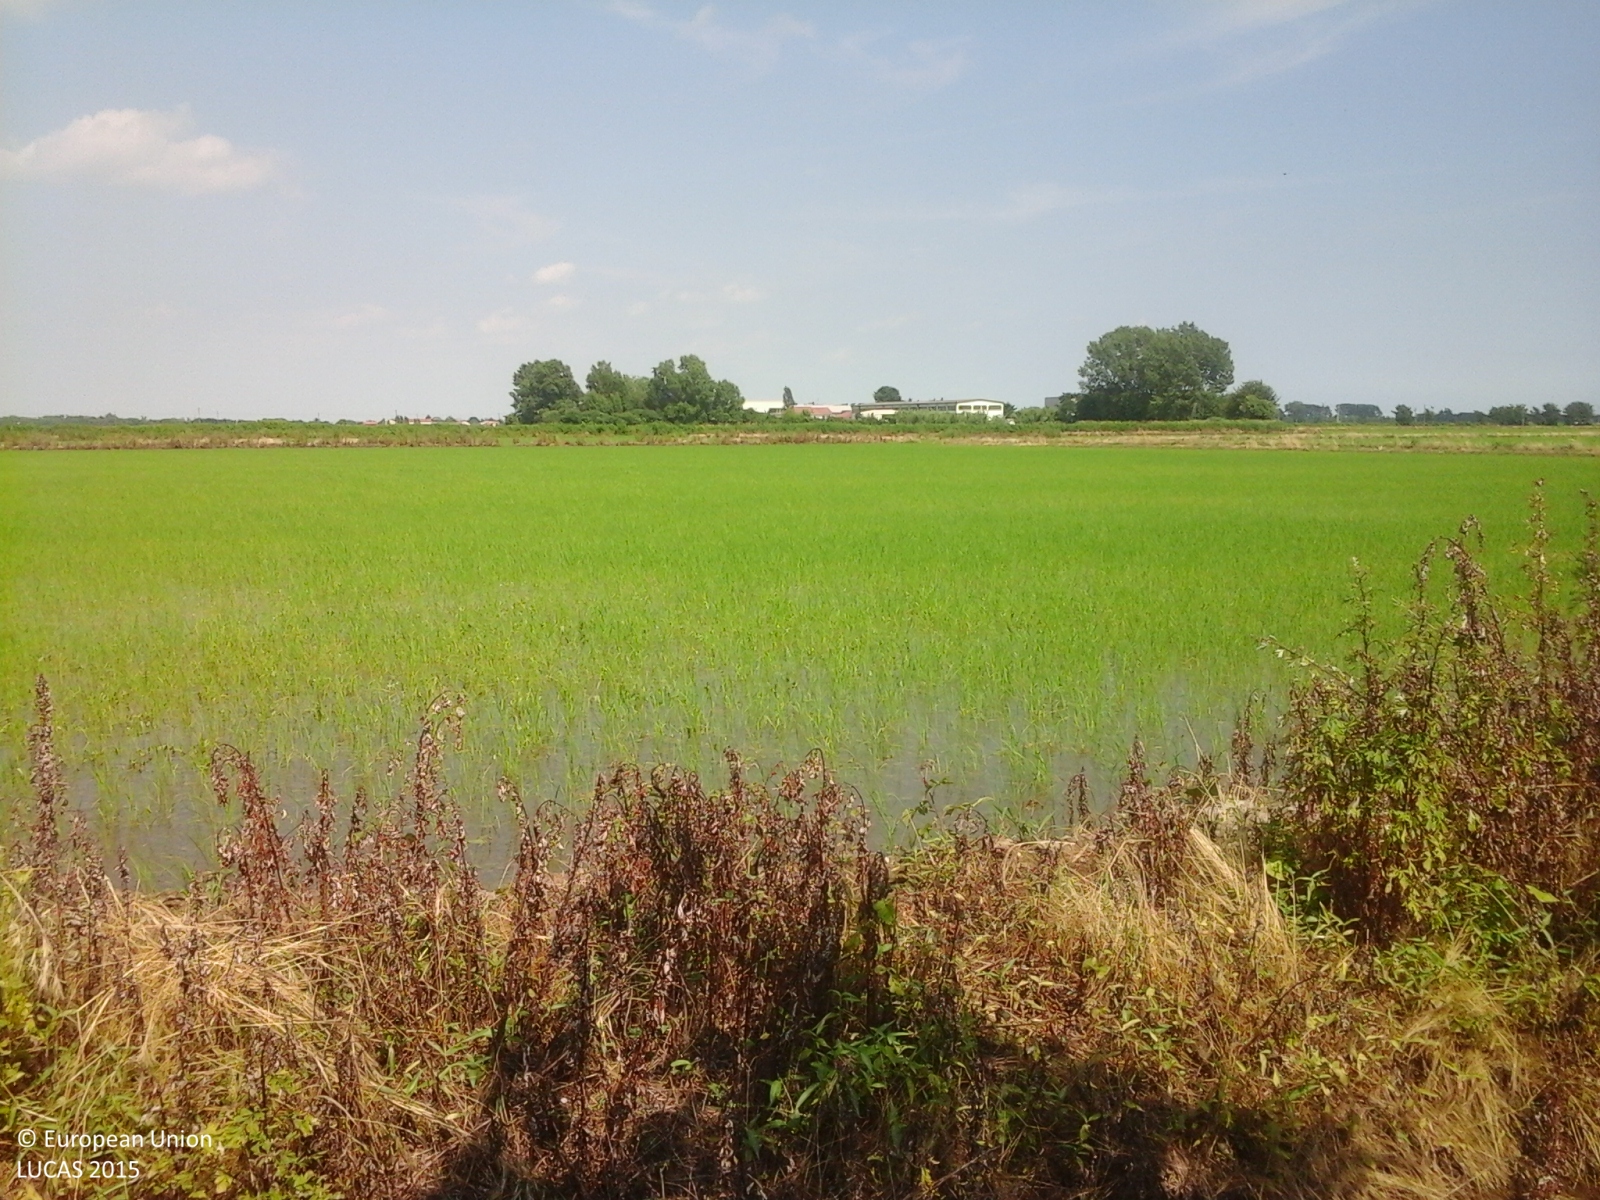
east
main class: Cropland
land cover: Rice
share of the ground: > 75 %
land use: Agriculture (excluding fallow land and kitchen gardens)
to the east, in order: Rice; Grass margins; Rice; Grass margins; Ditches and canals; Grass margins; Rice; Grass margins; Rice
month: June
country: IT
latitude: 45.3893
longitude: 8.7887
